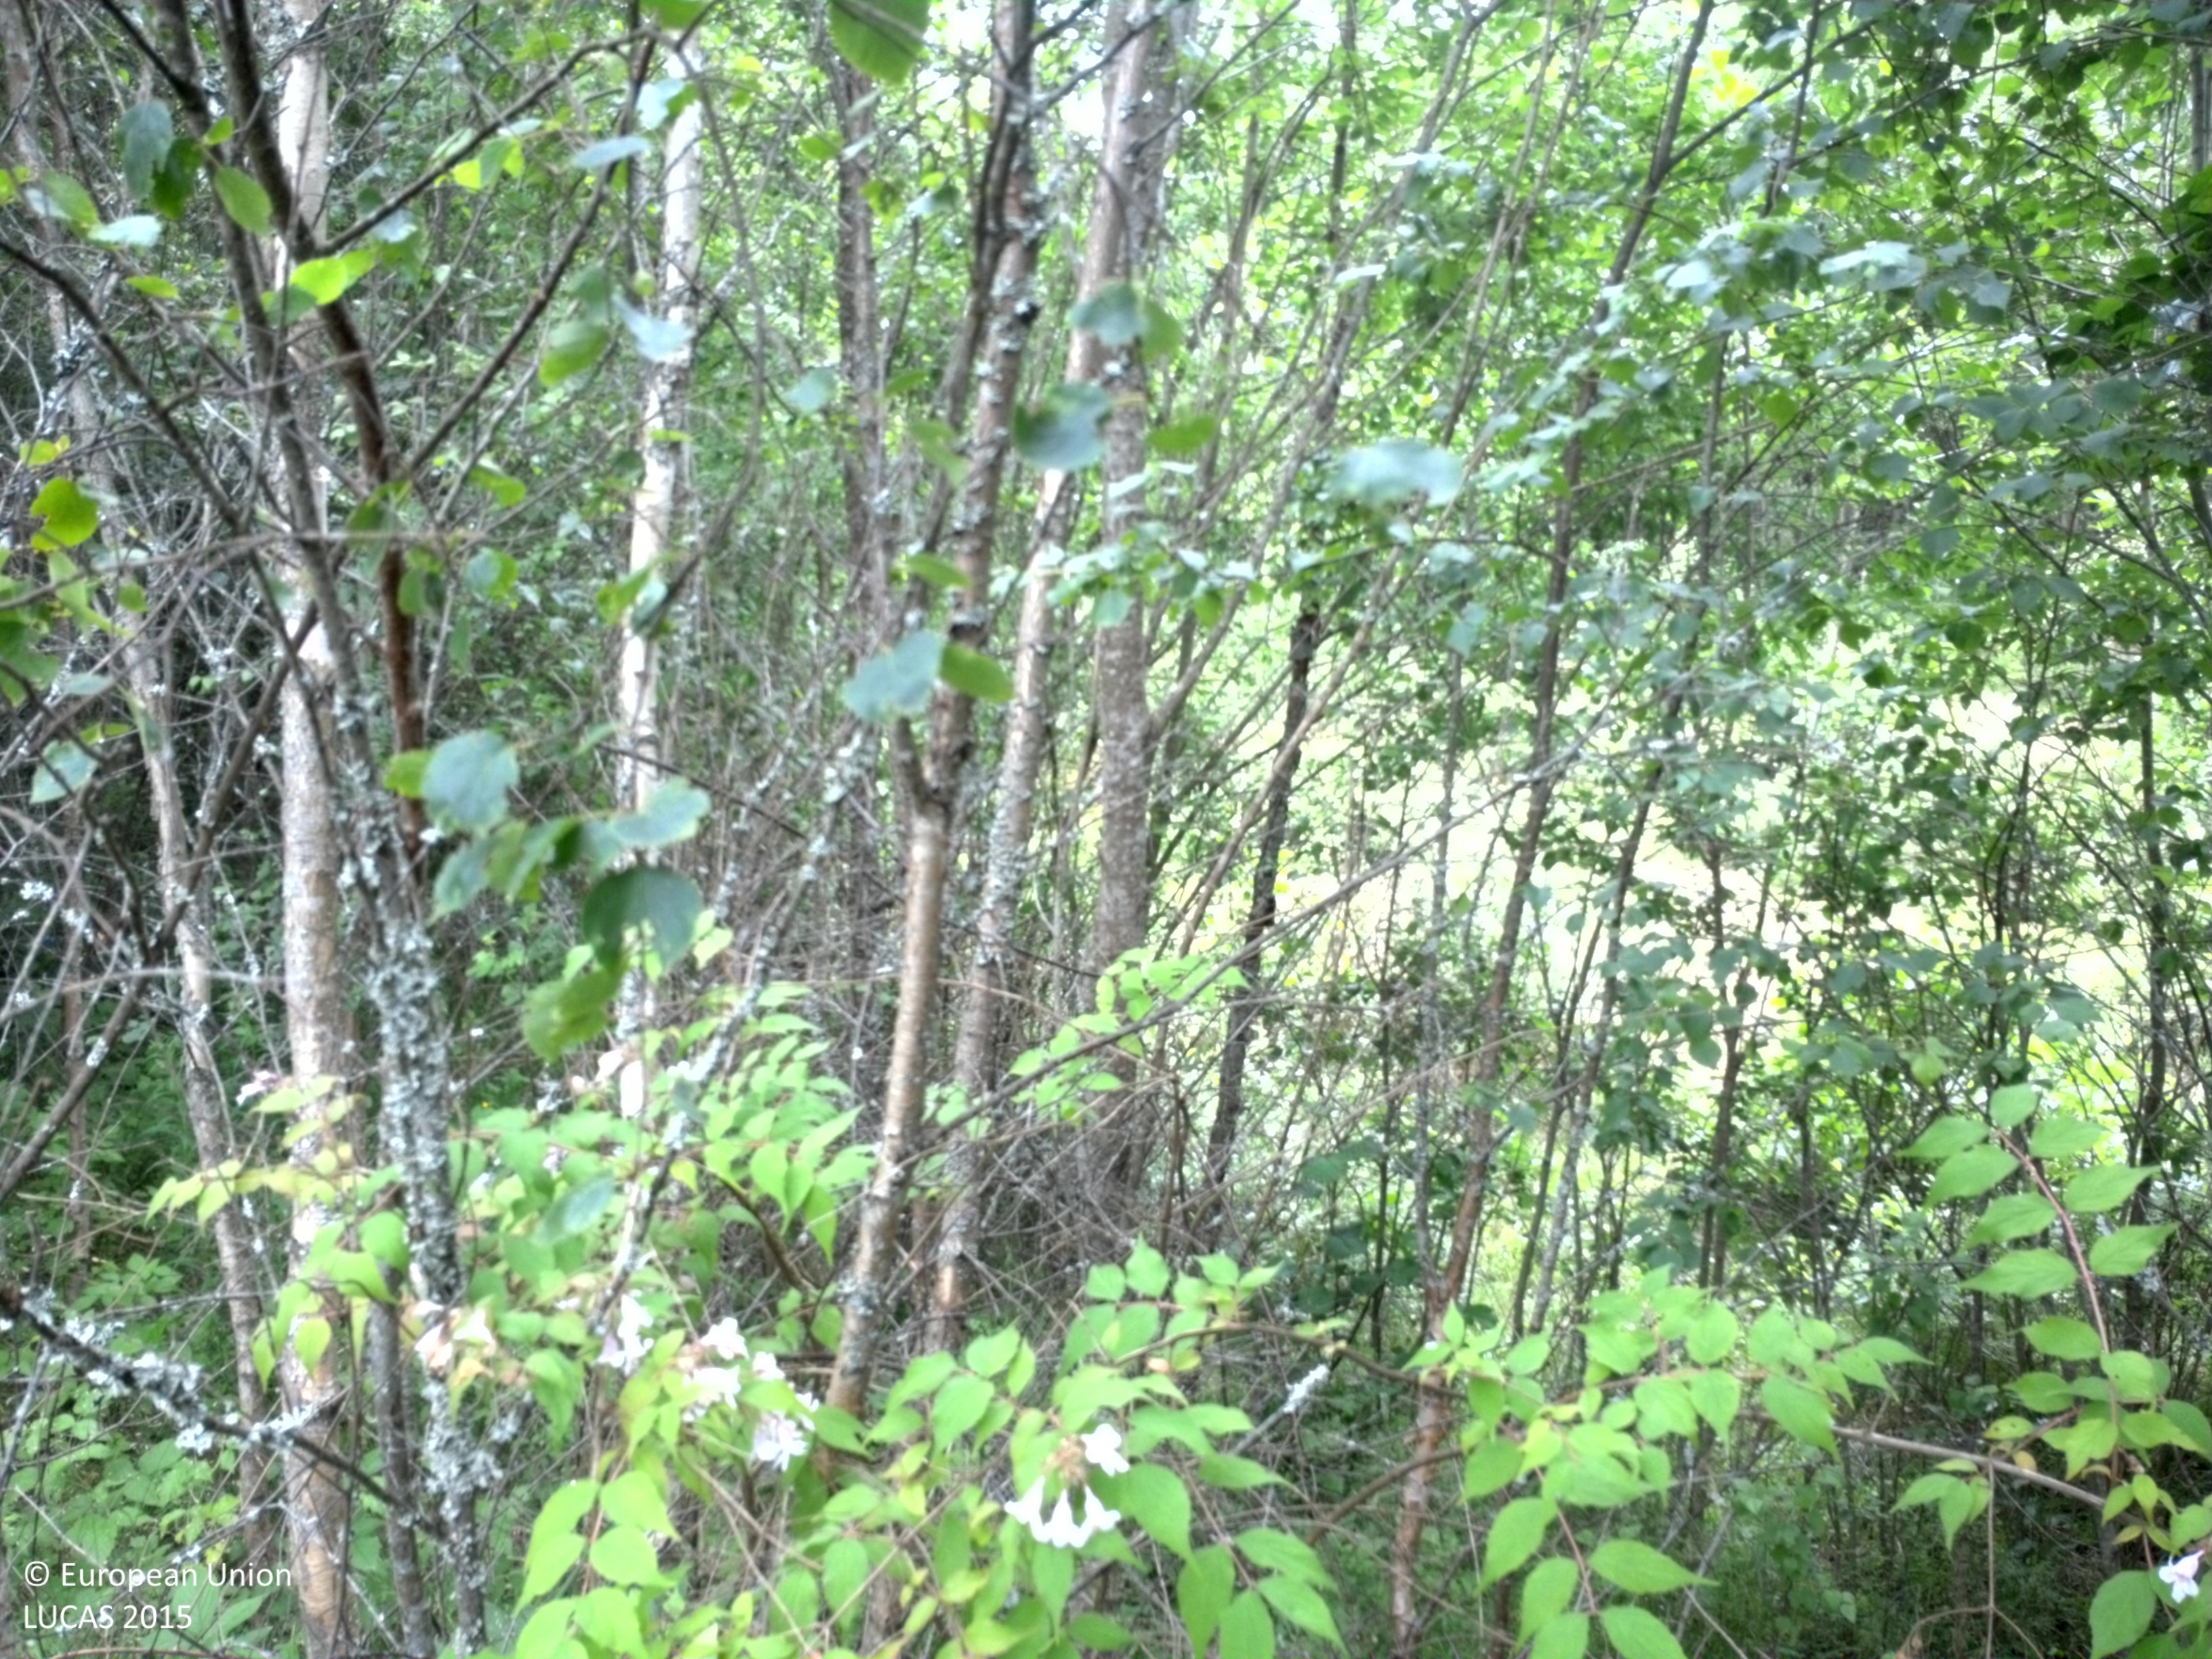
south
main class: Woodland
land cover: Broadleaved woodland
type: hemiboreal forest and nemoral coniferous forest and mixed broadleaved-coniferous forest
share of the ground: > 75 %
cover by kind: broadleaved forest trees 80 %, herbaceous plants 20 %
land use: Forestry
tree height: < 5 m
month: July
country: SE
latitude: 57.5228
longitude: 14.7546
